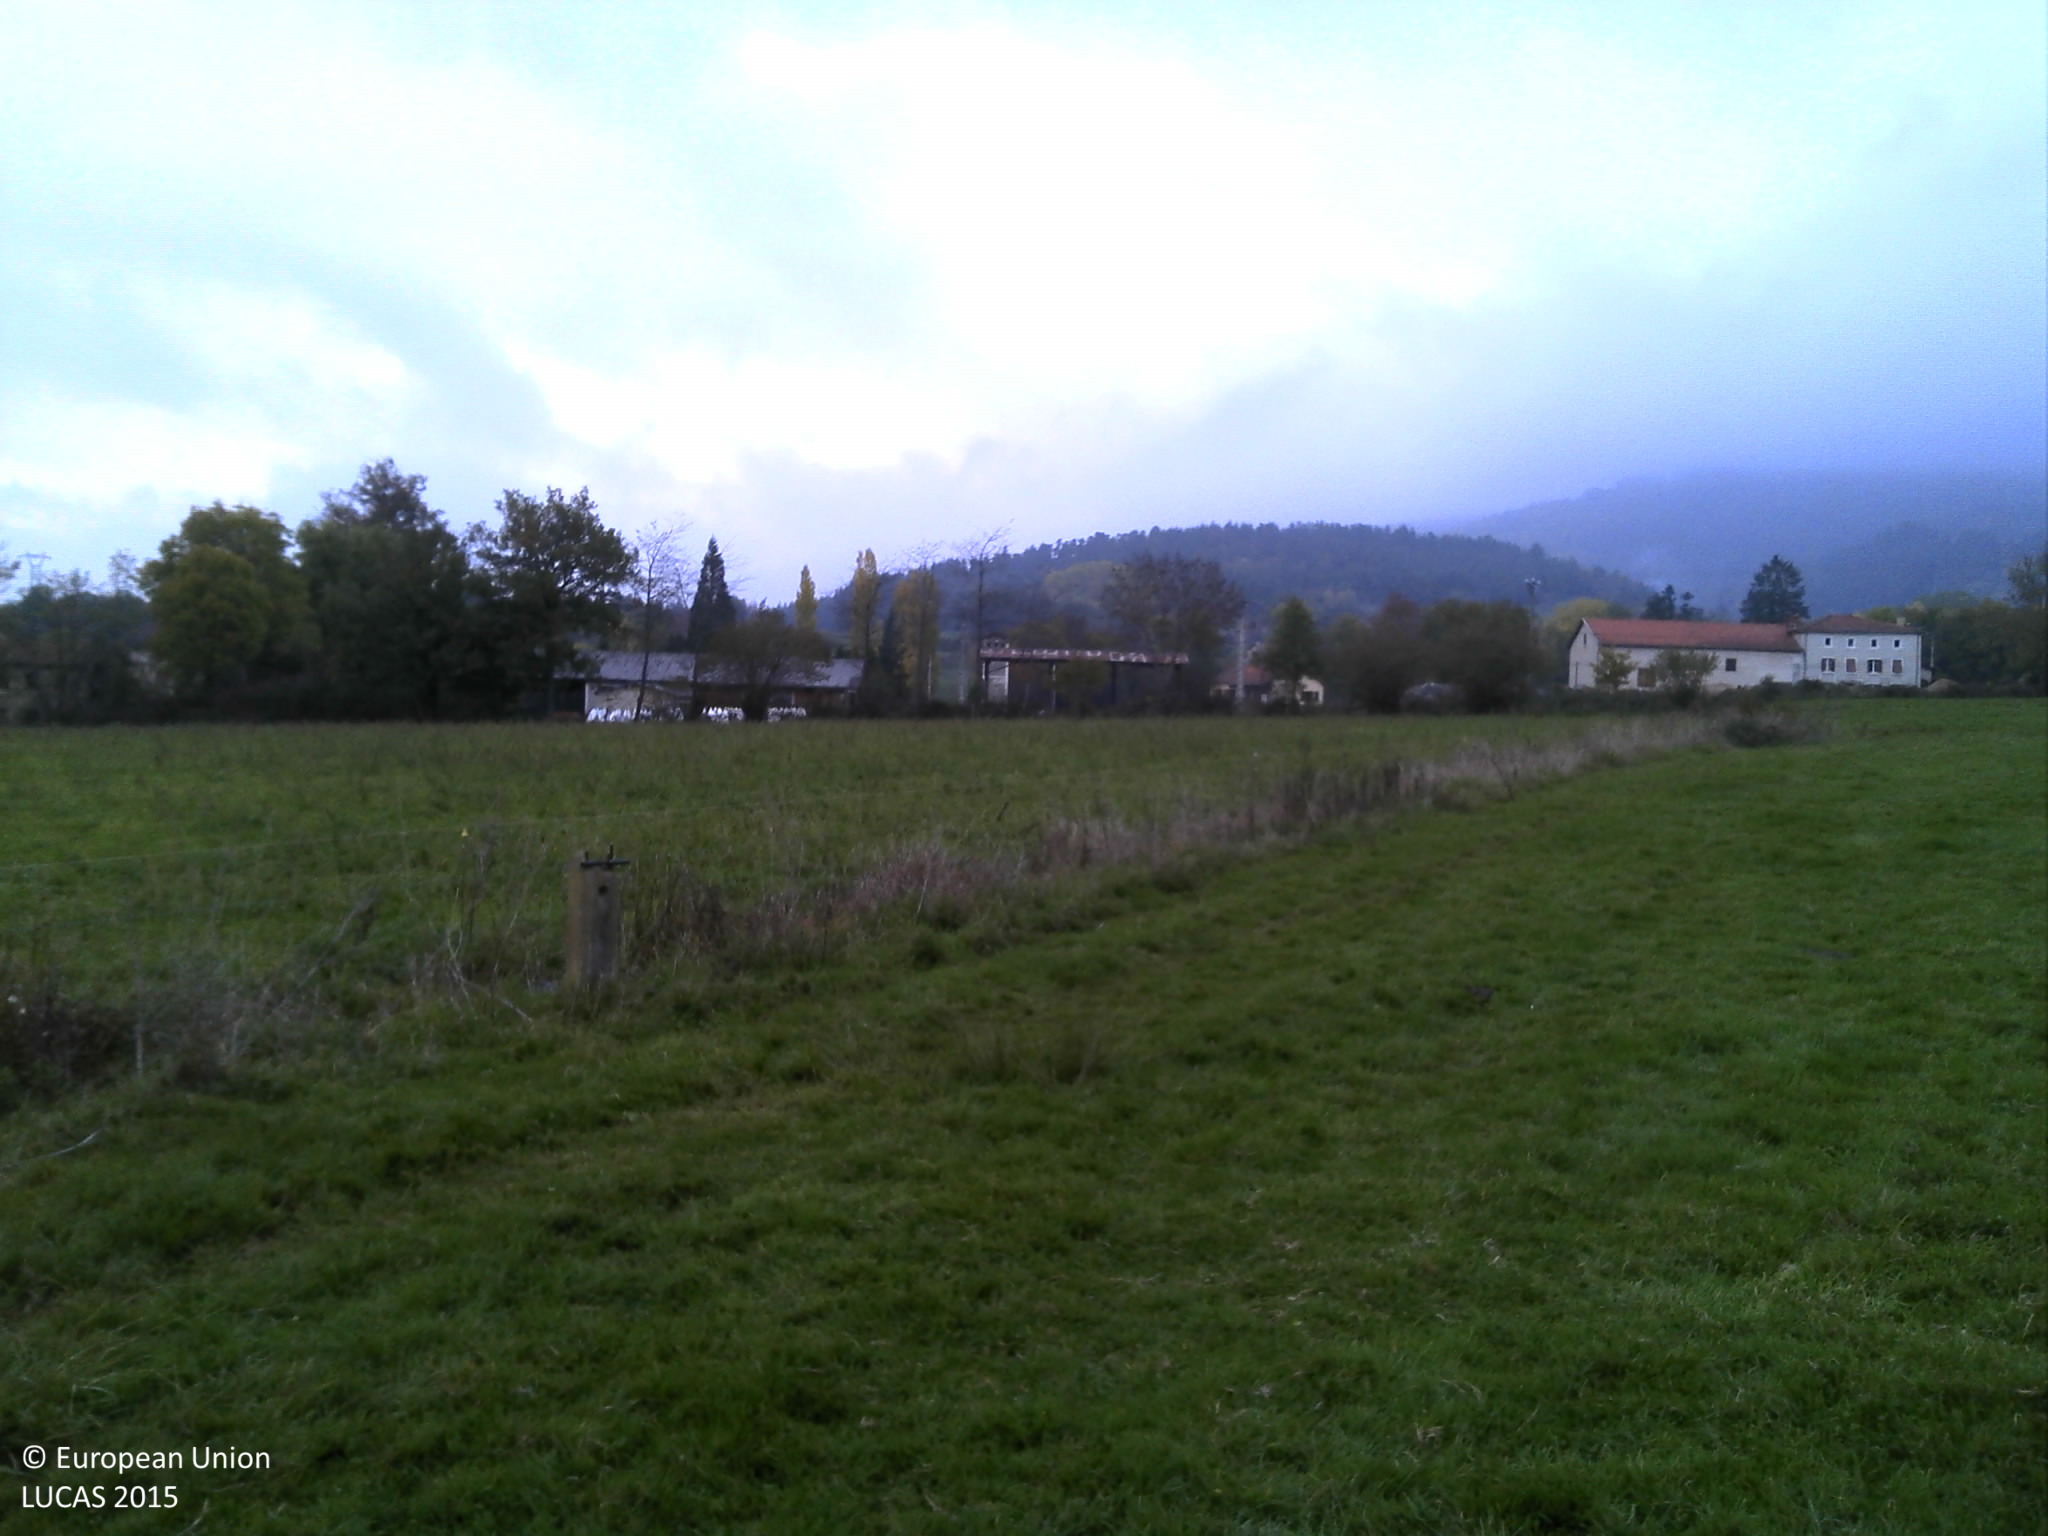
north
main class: Grassland
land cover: Grassland without tree/shrub cover
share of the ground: > 75 %
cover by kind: herbaceous plants 100 %
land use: Agriculture (excluding fallow land and kitchen gardens)
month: October
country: FR
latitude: 45.5370
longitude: 3.7658
